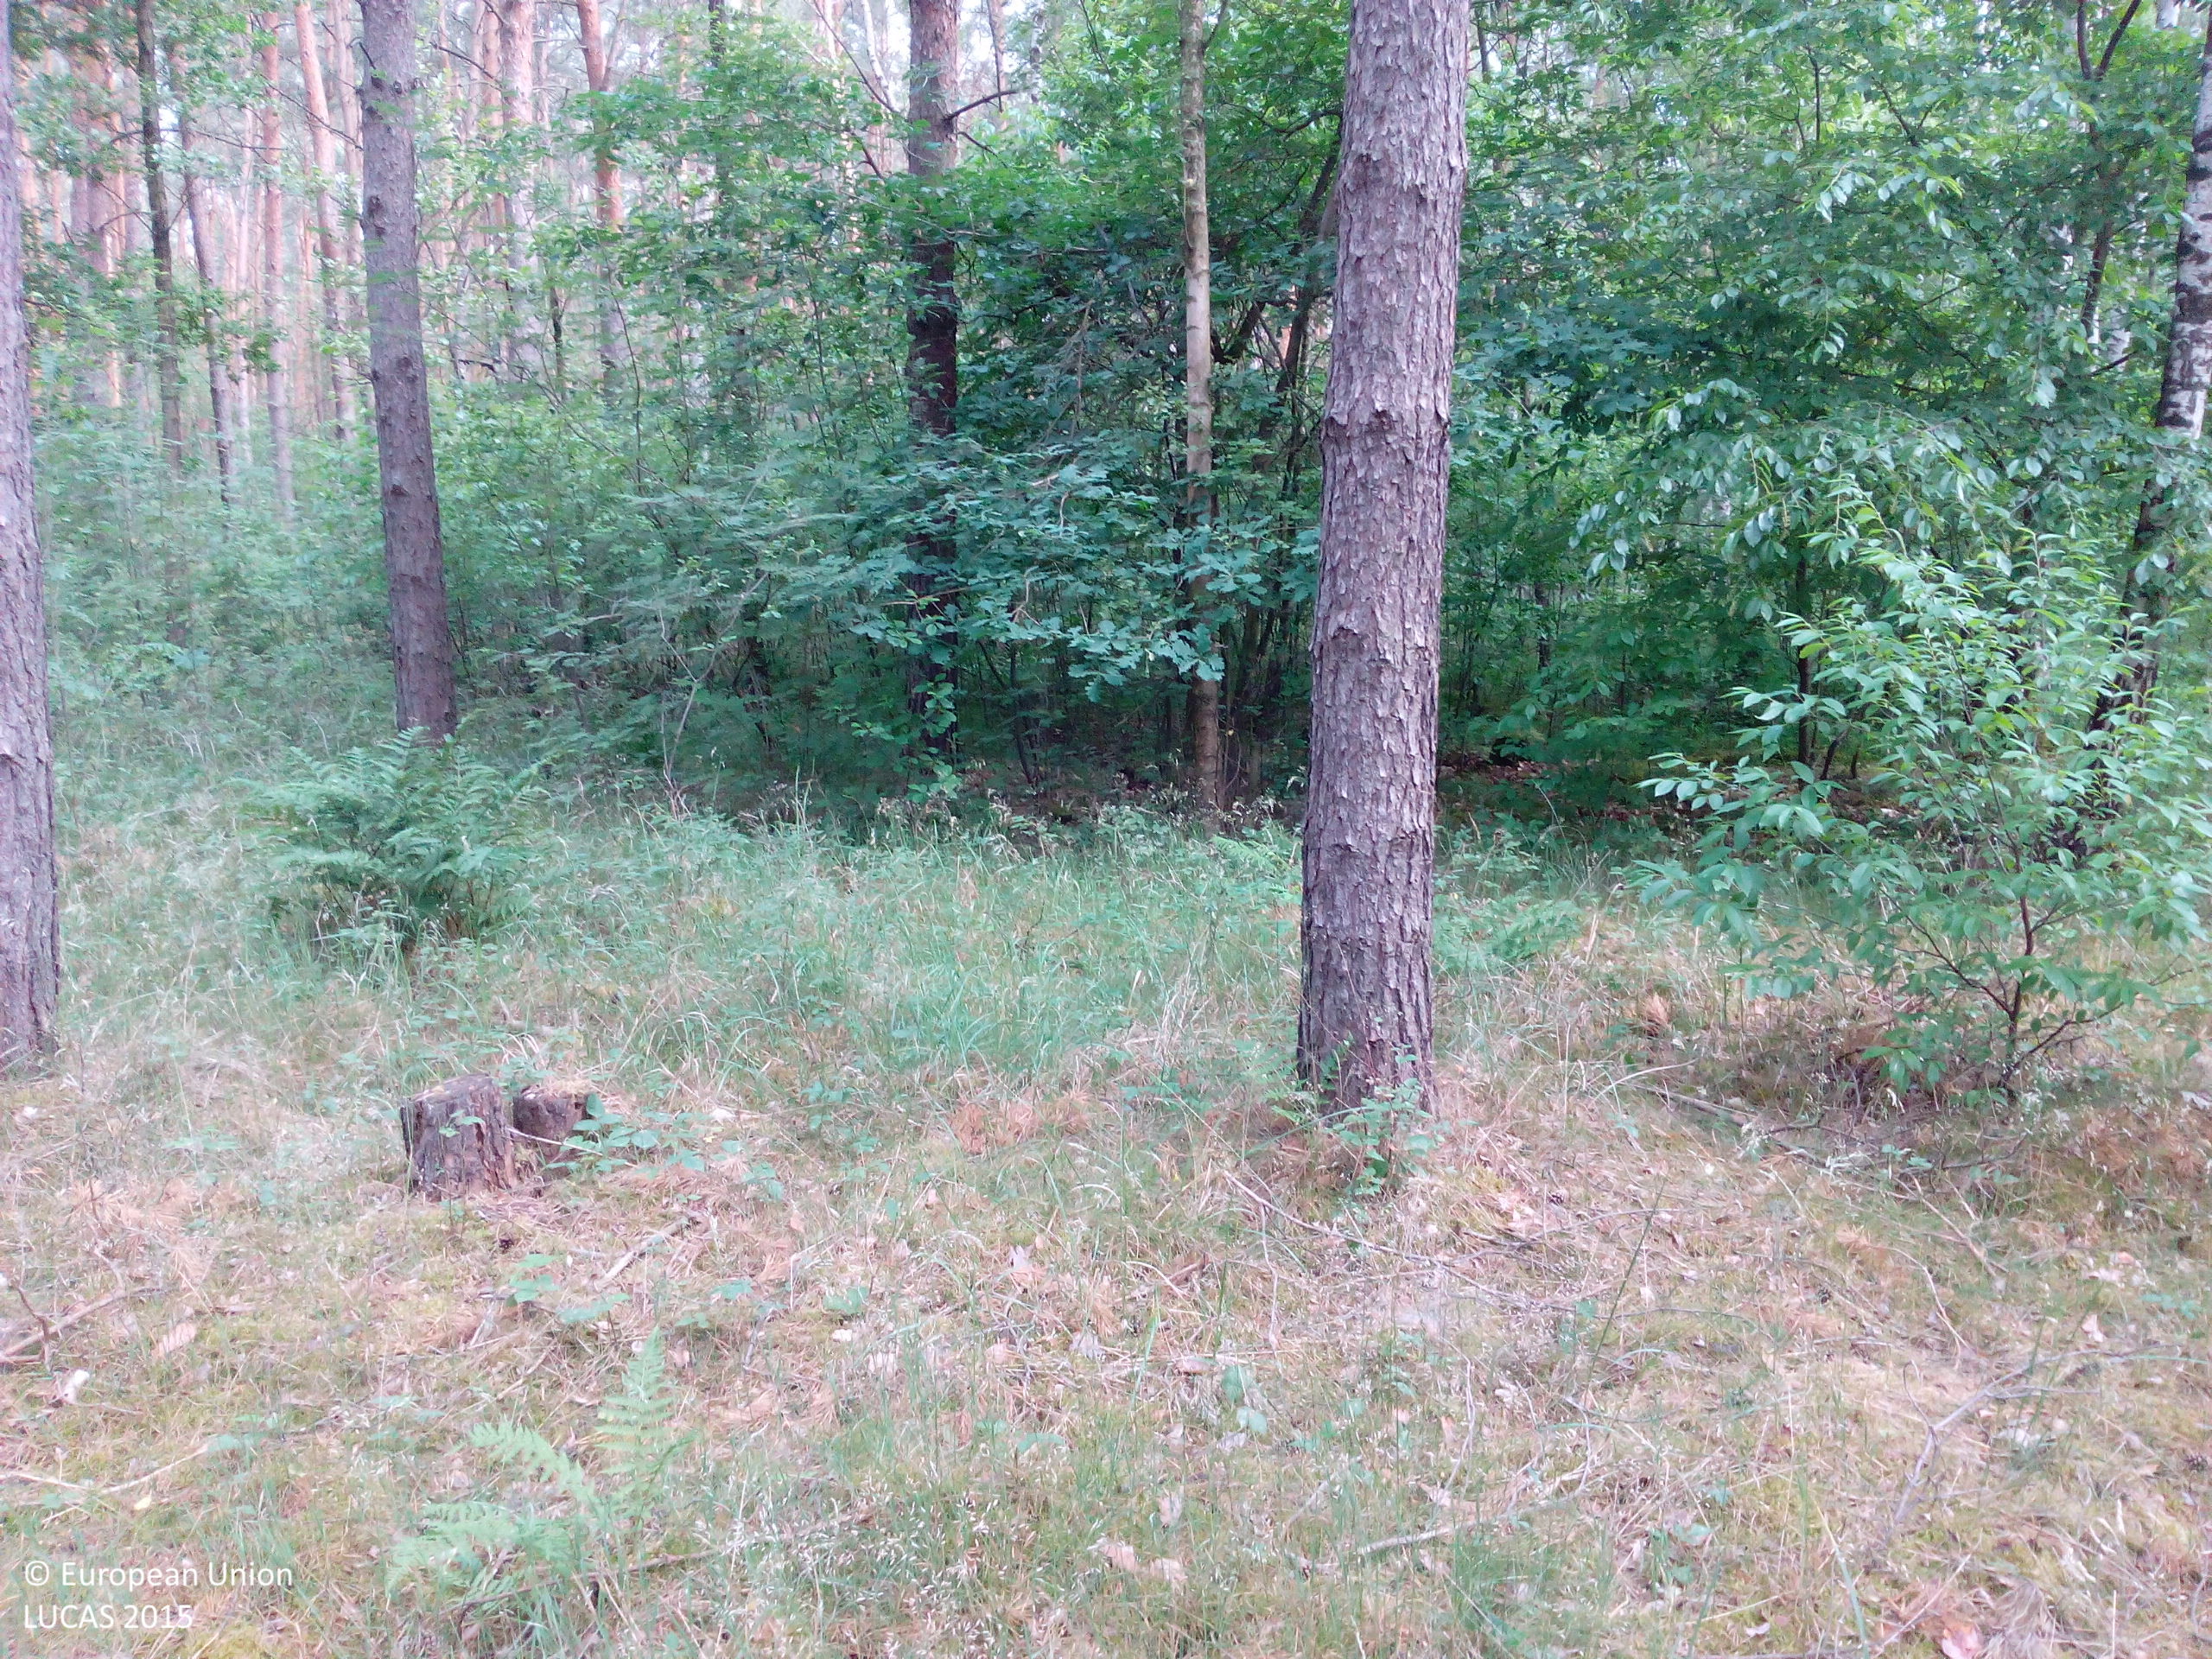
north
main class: Woodland
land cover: Pine dominated coniferous woodland
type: hemiboreal forest and nemoral coniferous forest and mixed broadleaved-coniferous forest
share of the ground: > 75 %
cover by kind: coniferous forest trees 80 %, broadleaved forest trees 15 %, shrubs 5 %
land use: Forestry
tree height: > 5 m
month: June
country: DE
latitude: 51.5408
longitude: 12.5518
